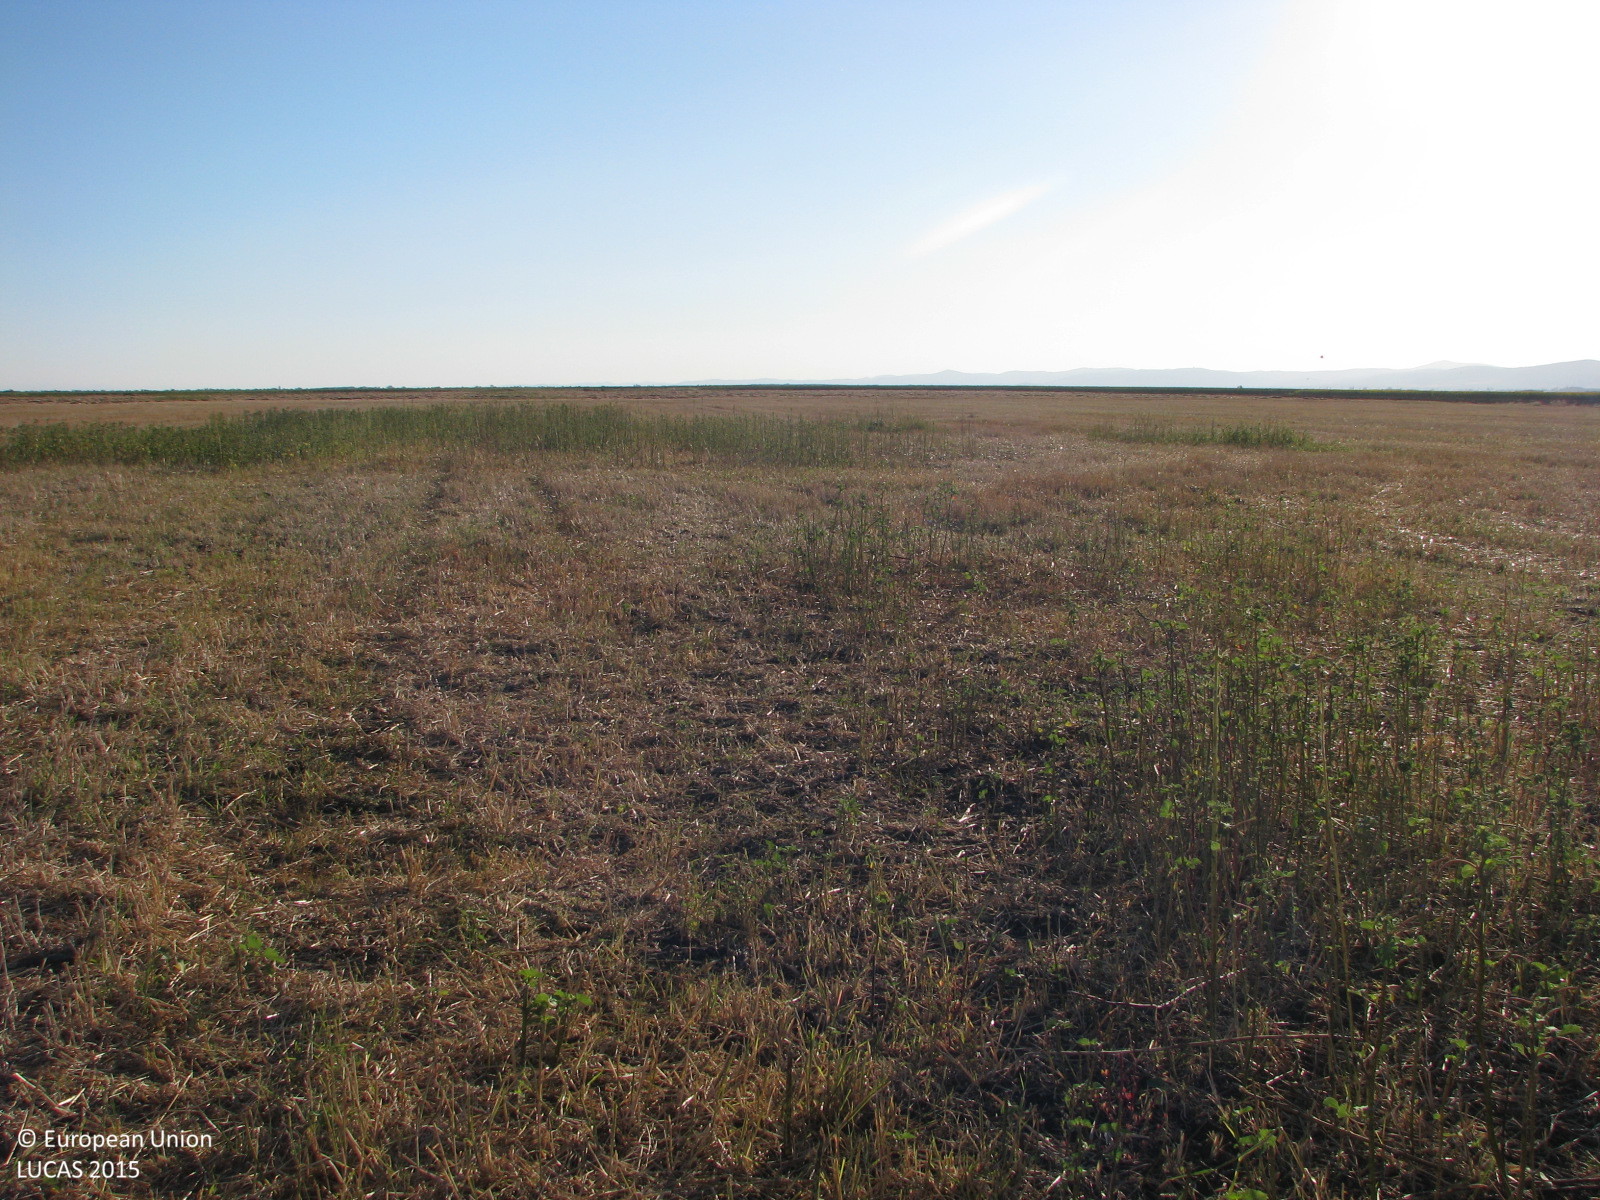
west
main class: Cropland
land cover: Common wheat
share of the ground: 10 - 25 %
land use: Agriculture (excluding fallow land and kitchen gardens)
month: July
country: BG
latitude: 42.4607
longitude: 25.9741
